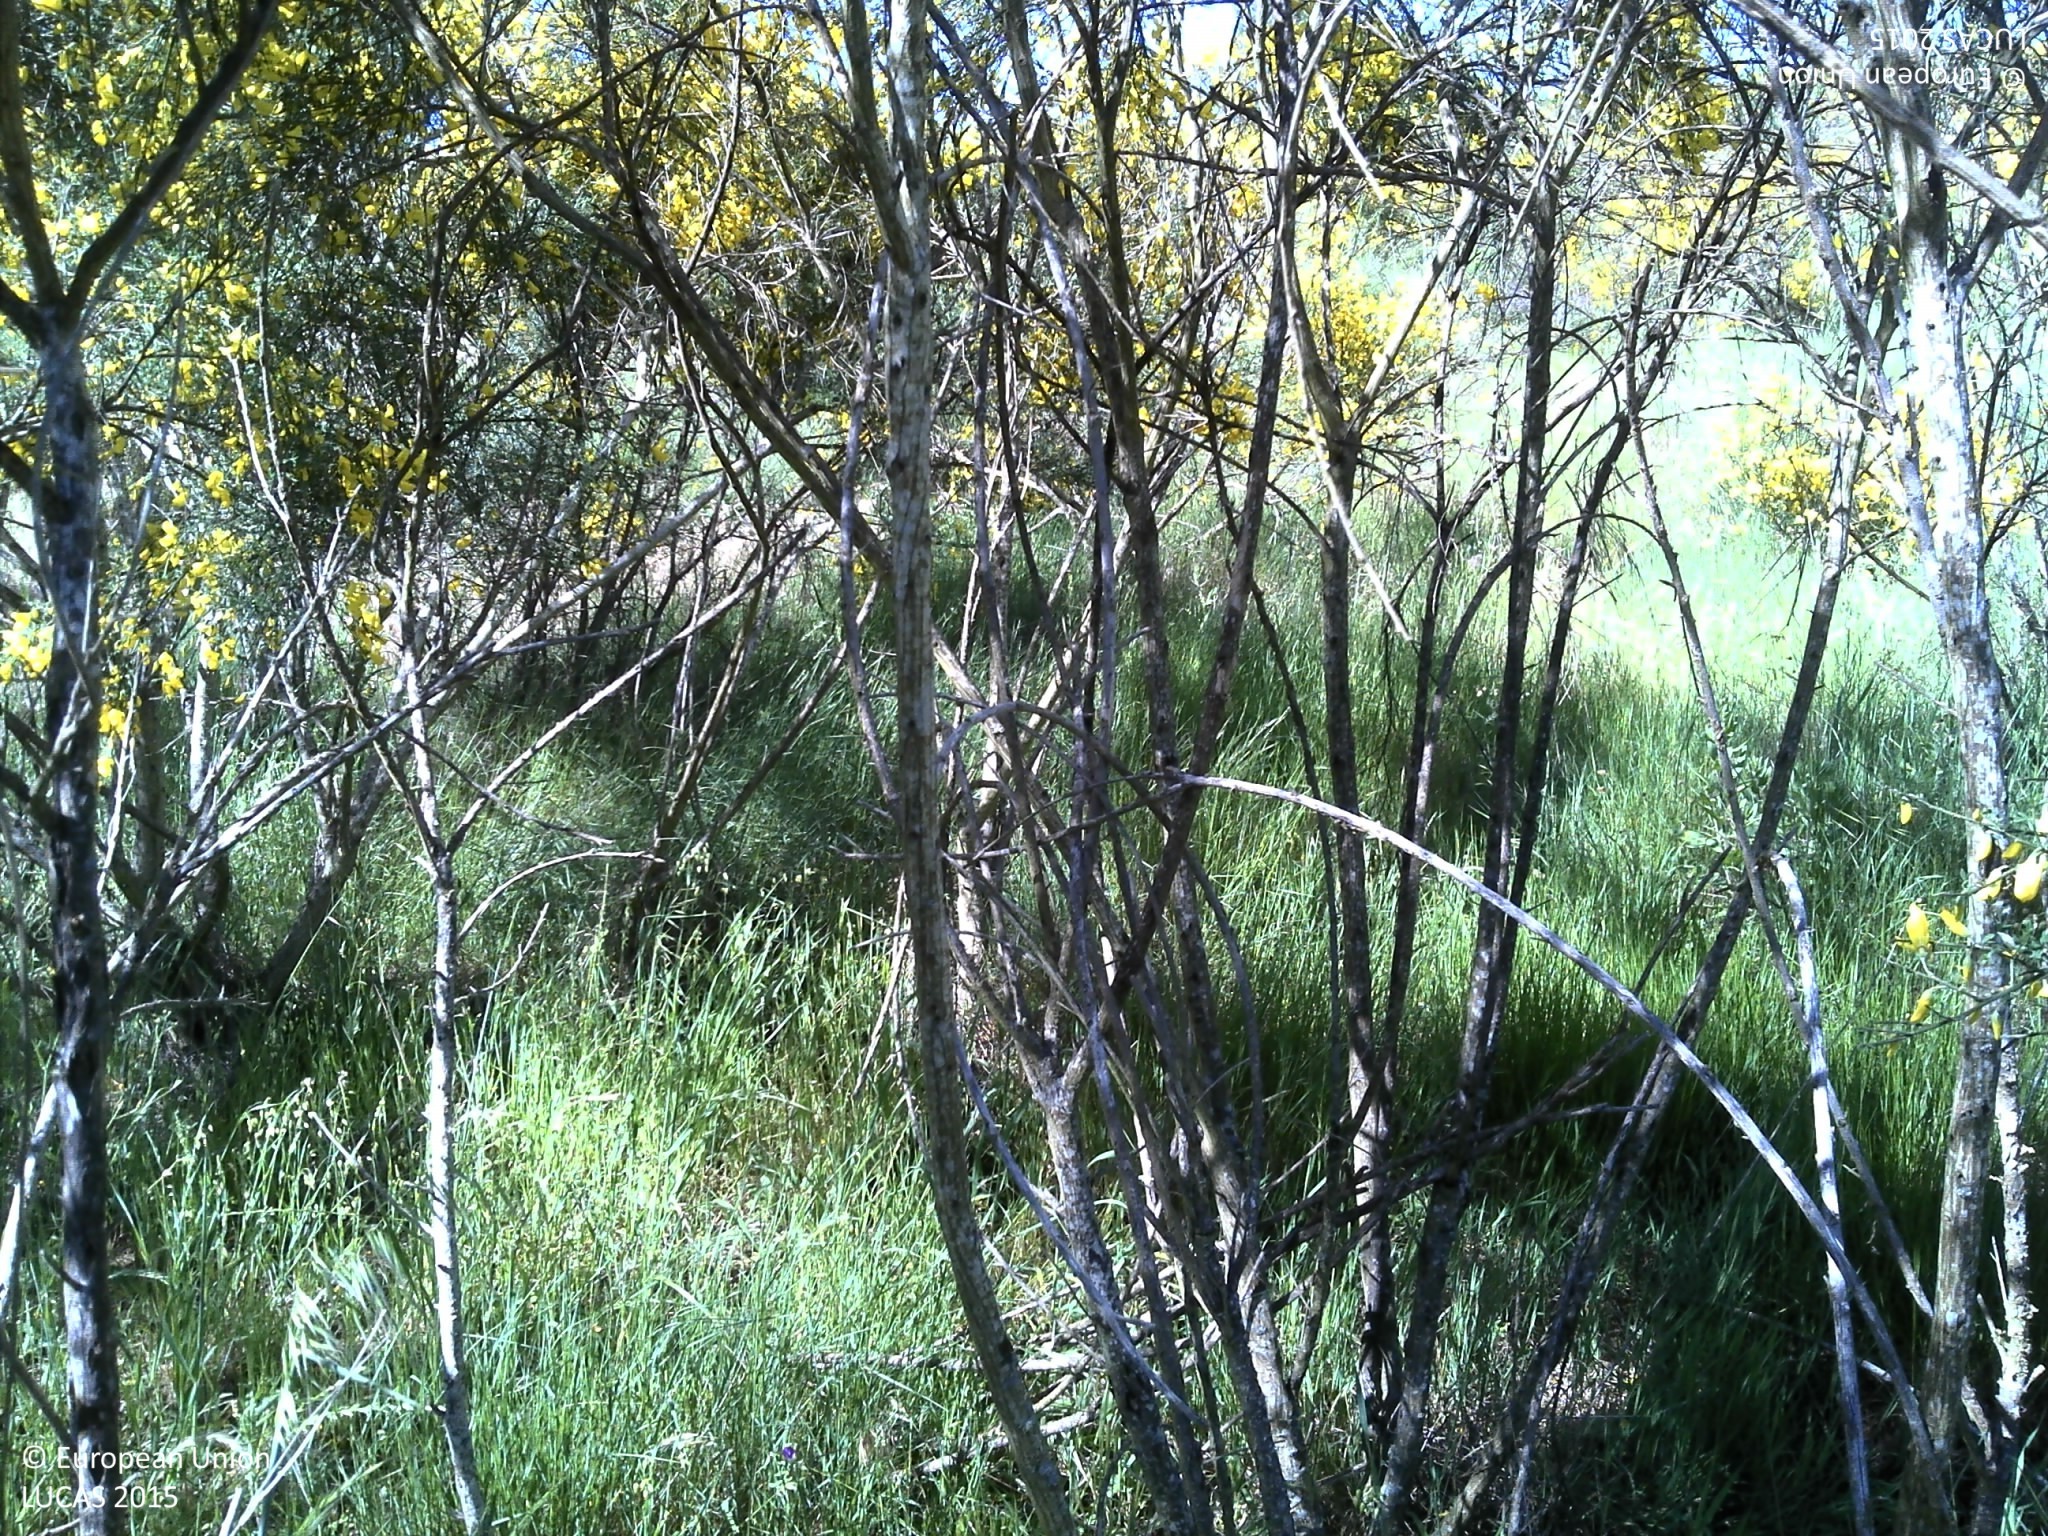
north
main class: Shrubland
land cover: Shrubland without tree cover
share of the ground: 50 - 75 %
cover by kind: shrubs 60 %, herbaceous plants 40 %
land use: Forestry
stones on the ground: < 10 %
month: May
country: PT
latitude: 41.8372
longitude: -7.3858
